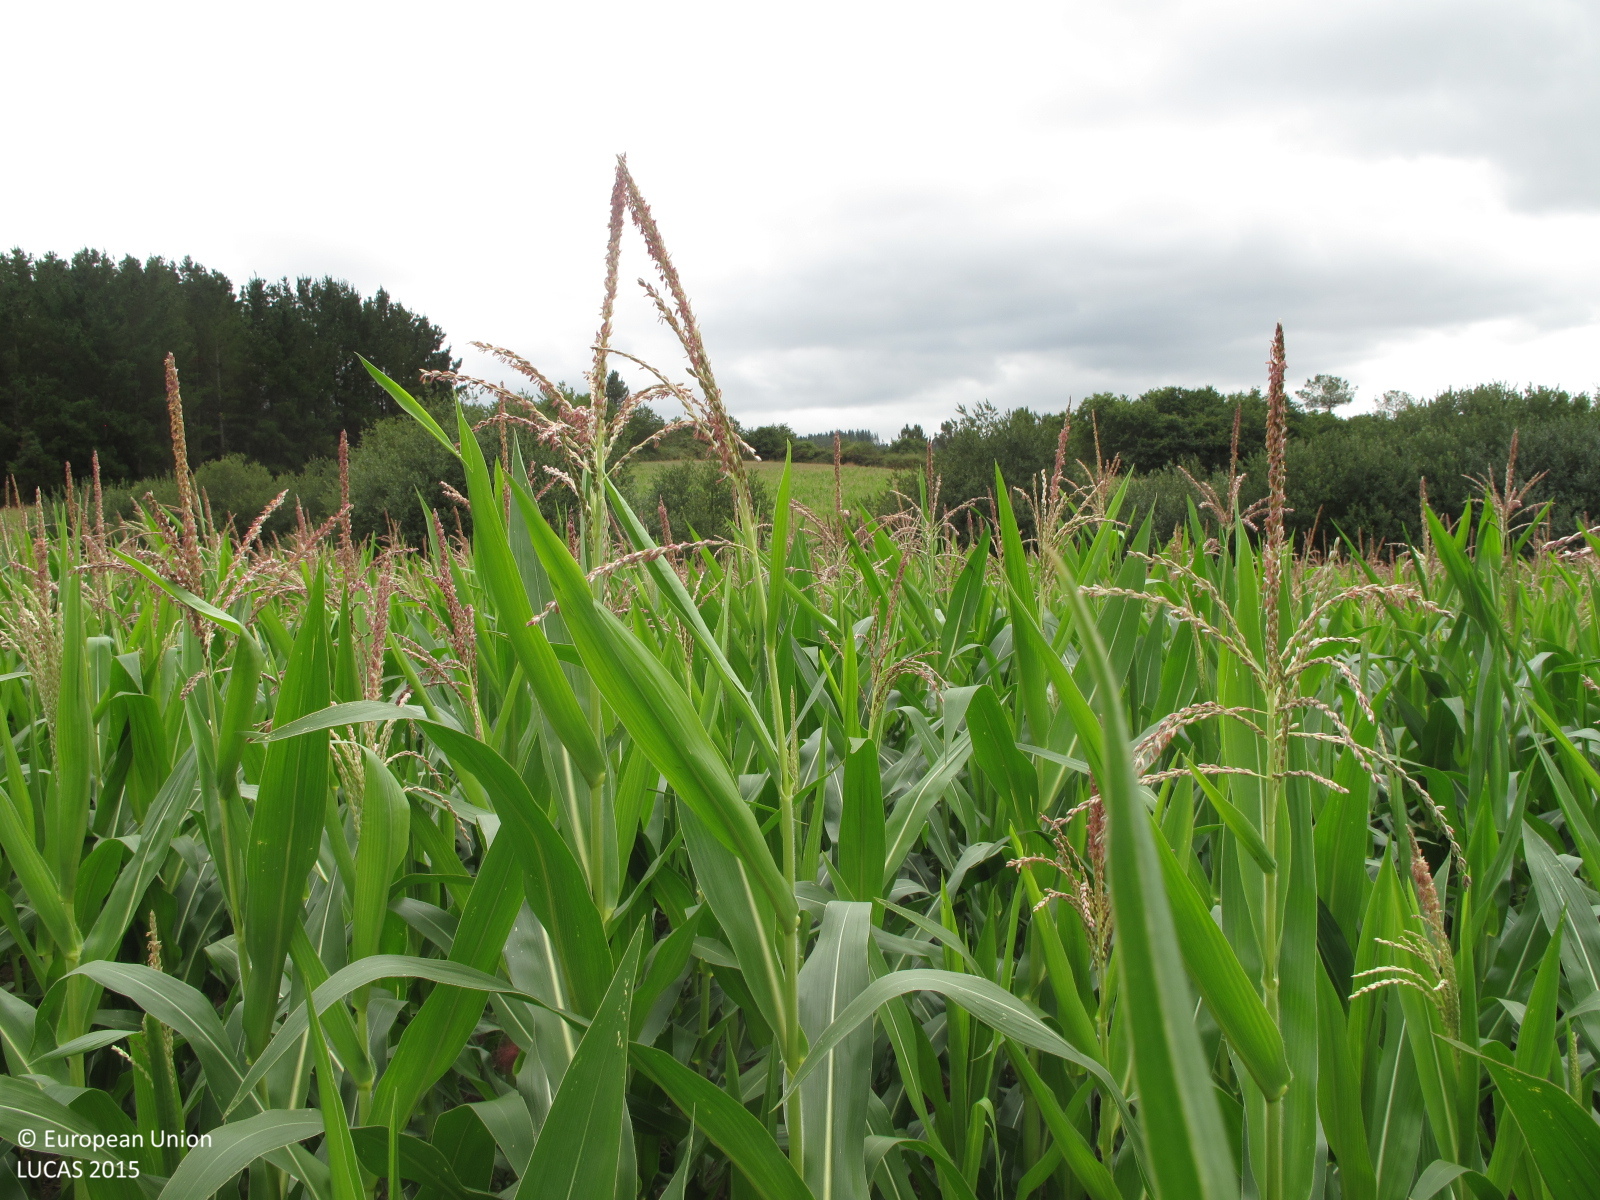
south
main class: Cropland
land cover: Maize
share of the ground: > 75 %
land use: Agriculture (excluding fallow land and kitchen gardens)
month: July
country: ES
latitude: 42.9156
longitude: -8.4655
